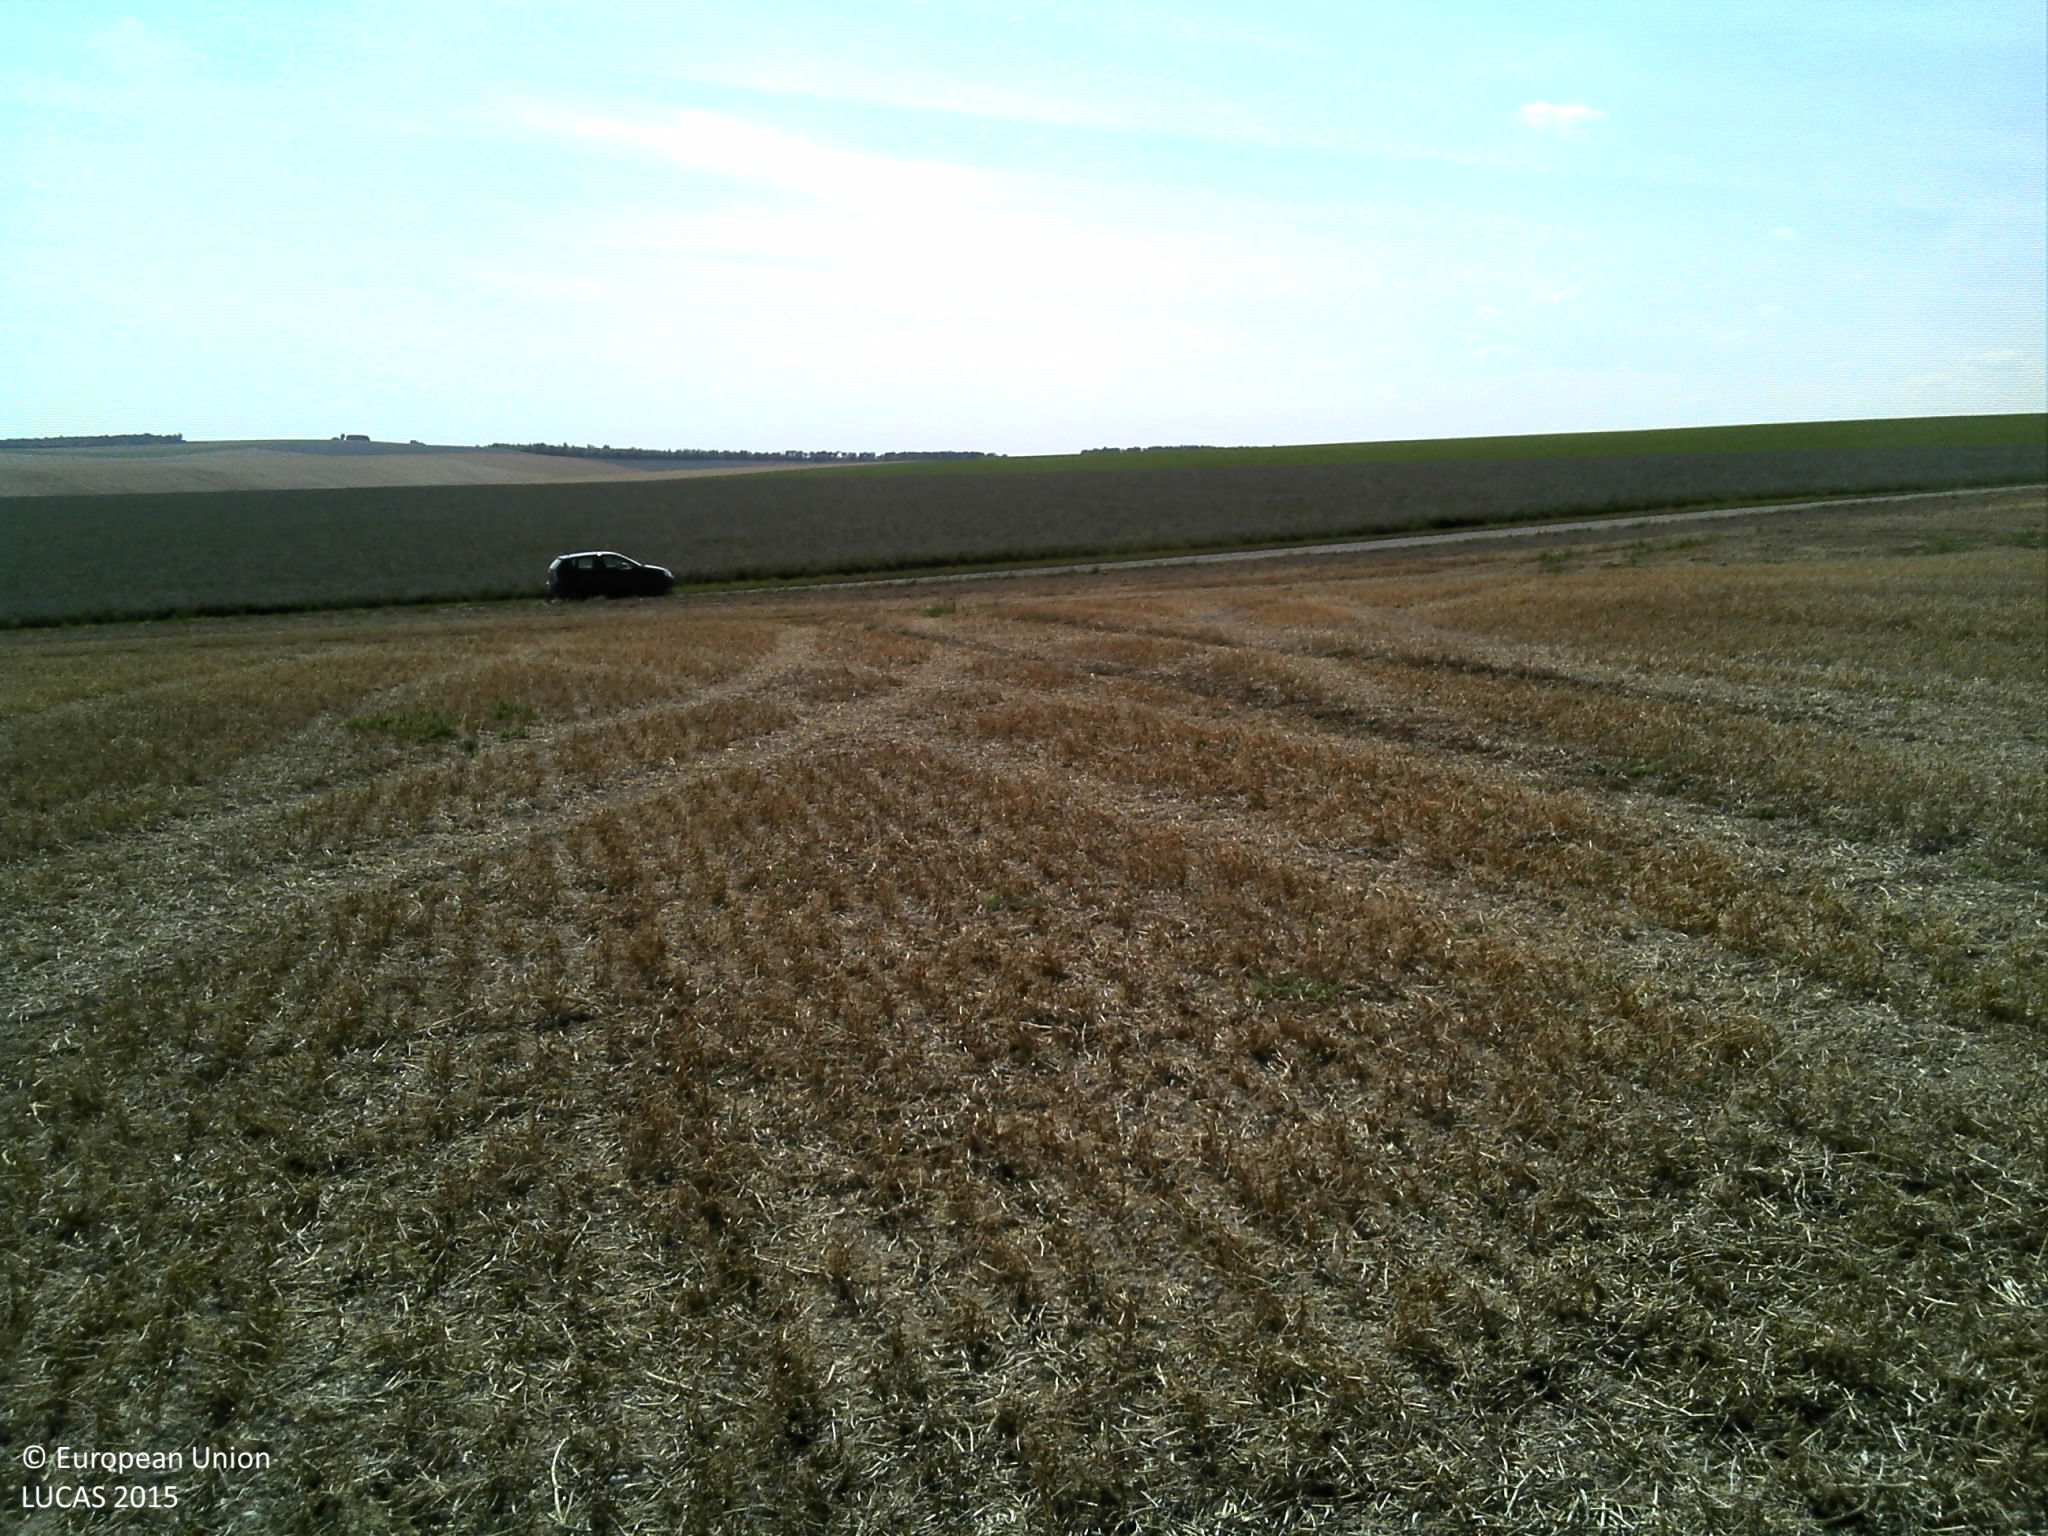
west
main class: Cropland
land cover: Dry pulses
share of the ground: > 75 %
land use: Agriculture (excluding fallow land and kitchen gardens)
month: August
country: FR
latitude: 48.9402
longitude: 4.6316
